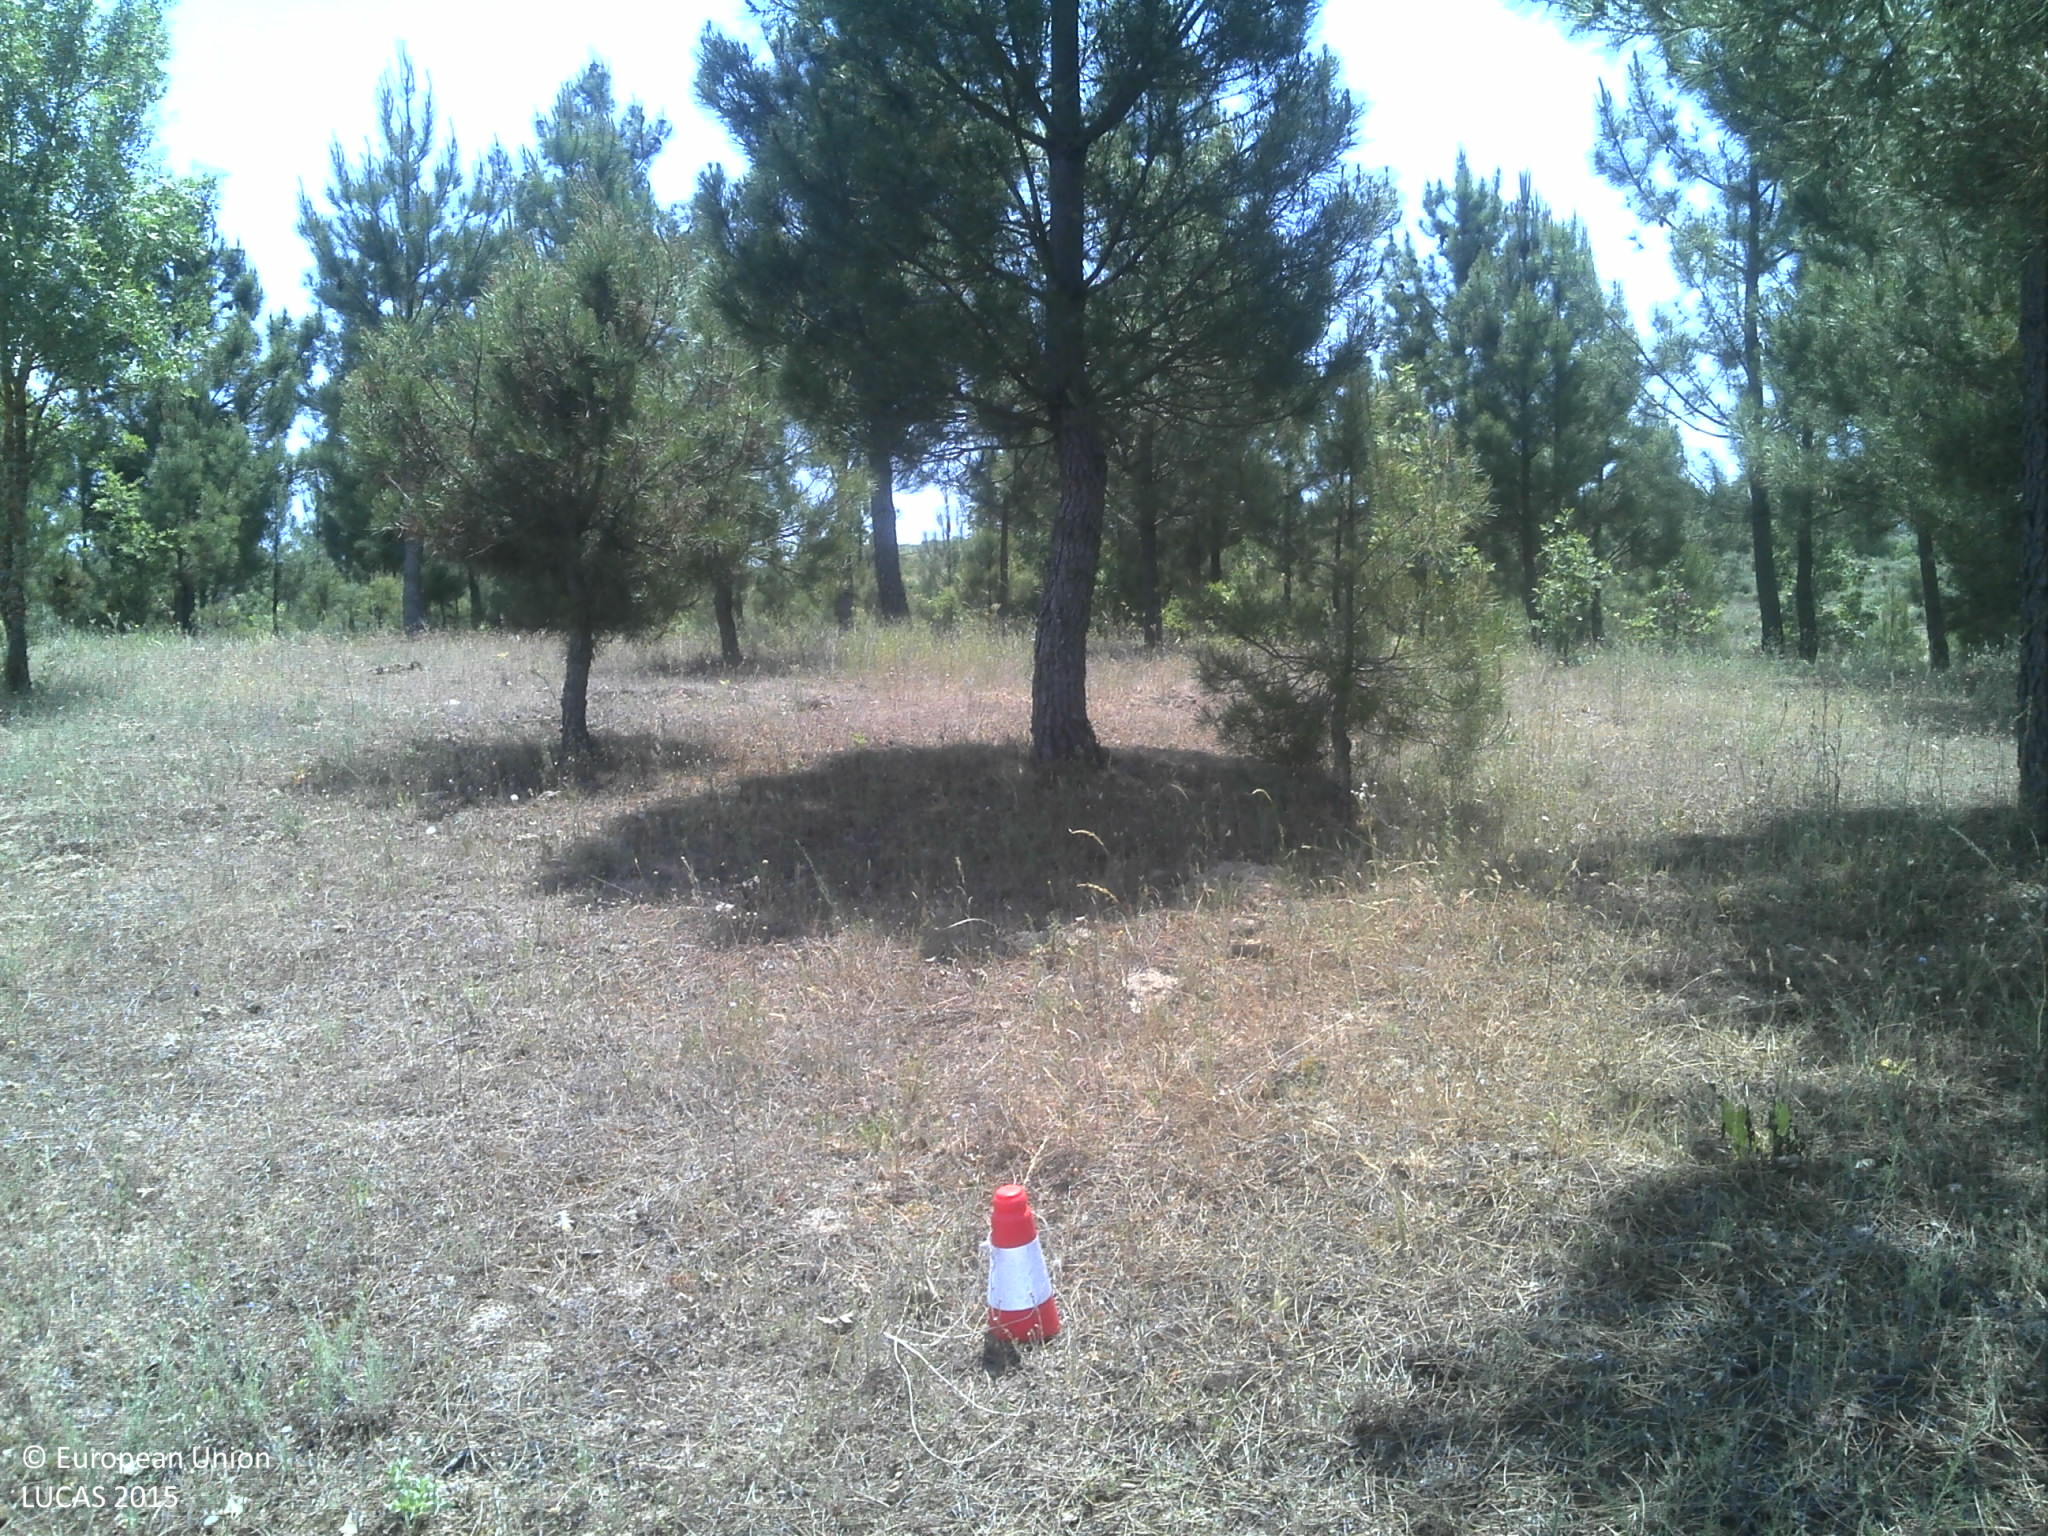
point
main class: Woodland
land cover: Pine dominated coniferous woodland
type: coniferous forest of the mediterranean region
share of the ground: 25 - 50 %
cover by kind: coniferous forest trees 50 %, unconsolidated bare surface 15 %, shrubs 10 %, herbaceous plants 10 %, lichens and mosses 10 %, broadleaved forest trees 5 %
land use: Forestry
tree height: > 5 m
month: June
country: PT
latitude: 40.5164
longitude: -7.0368
